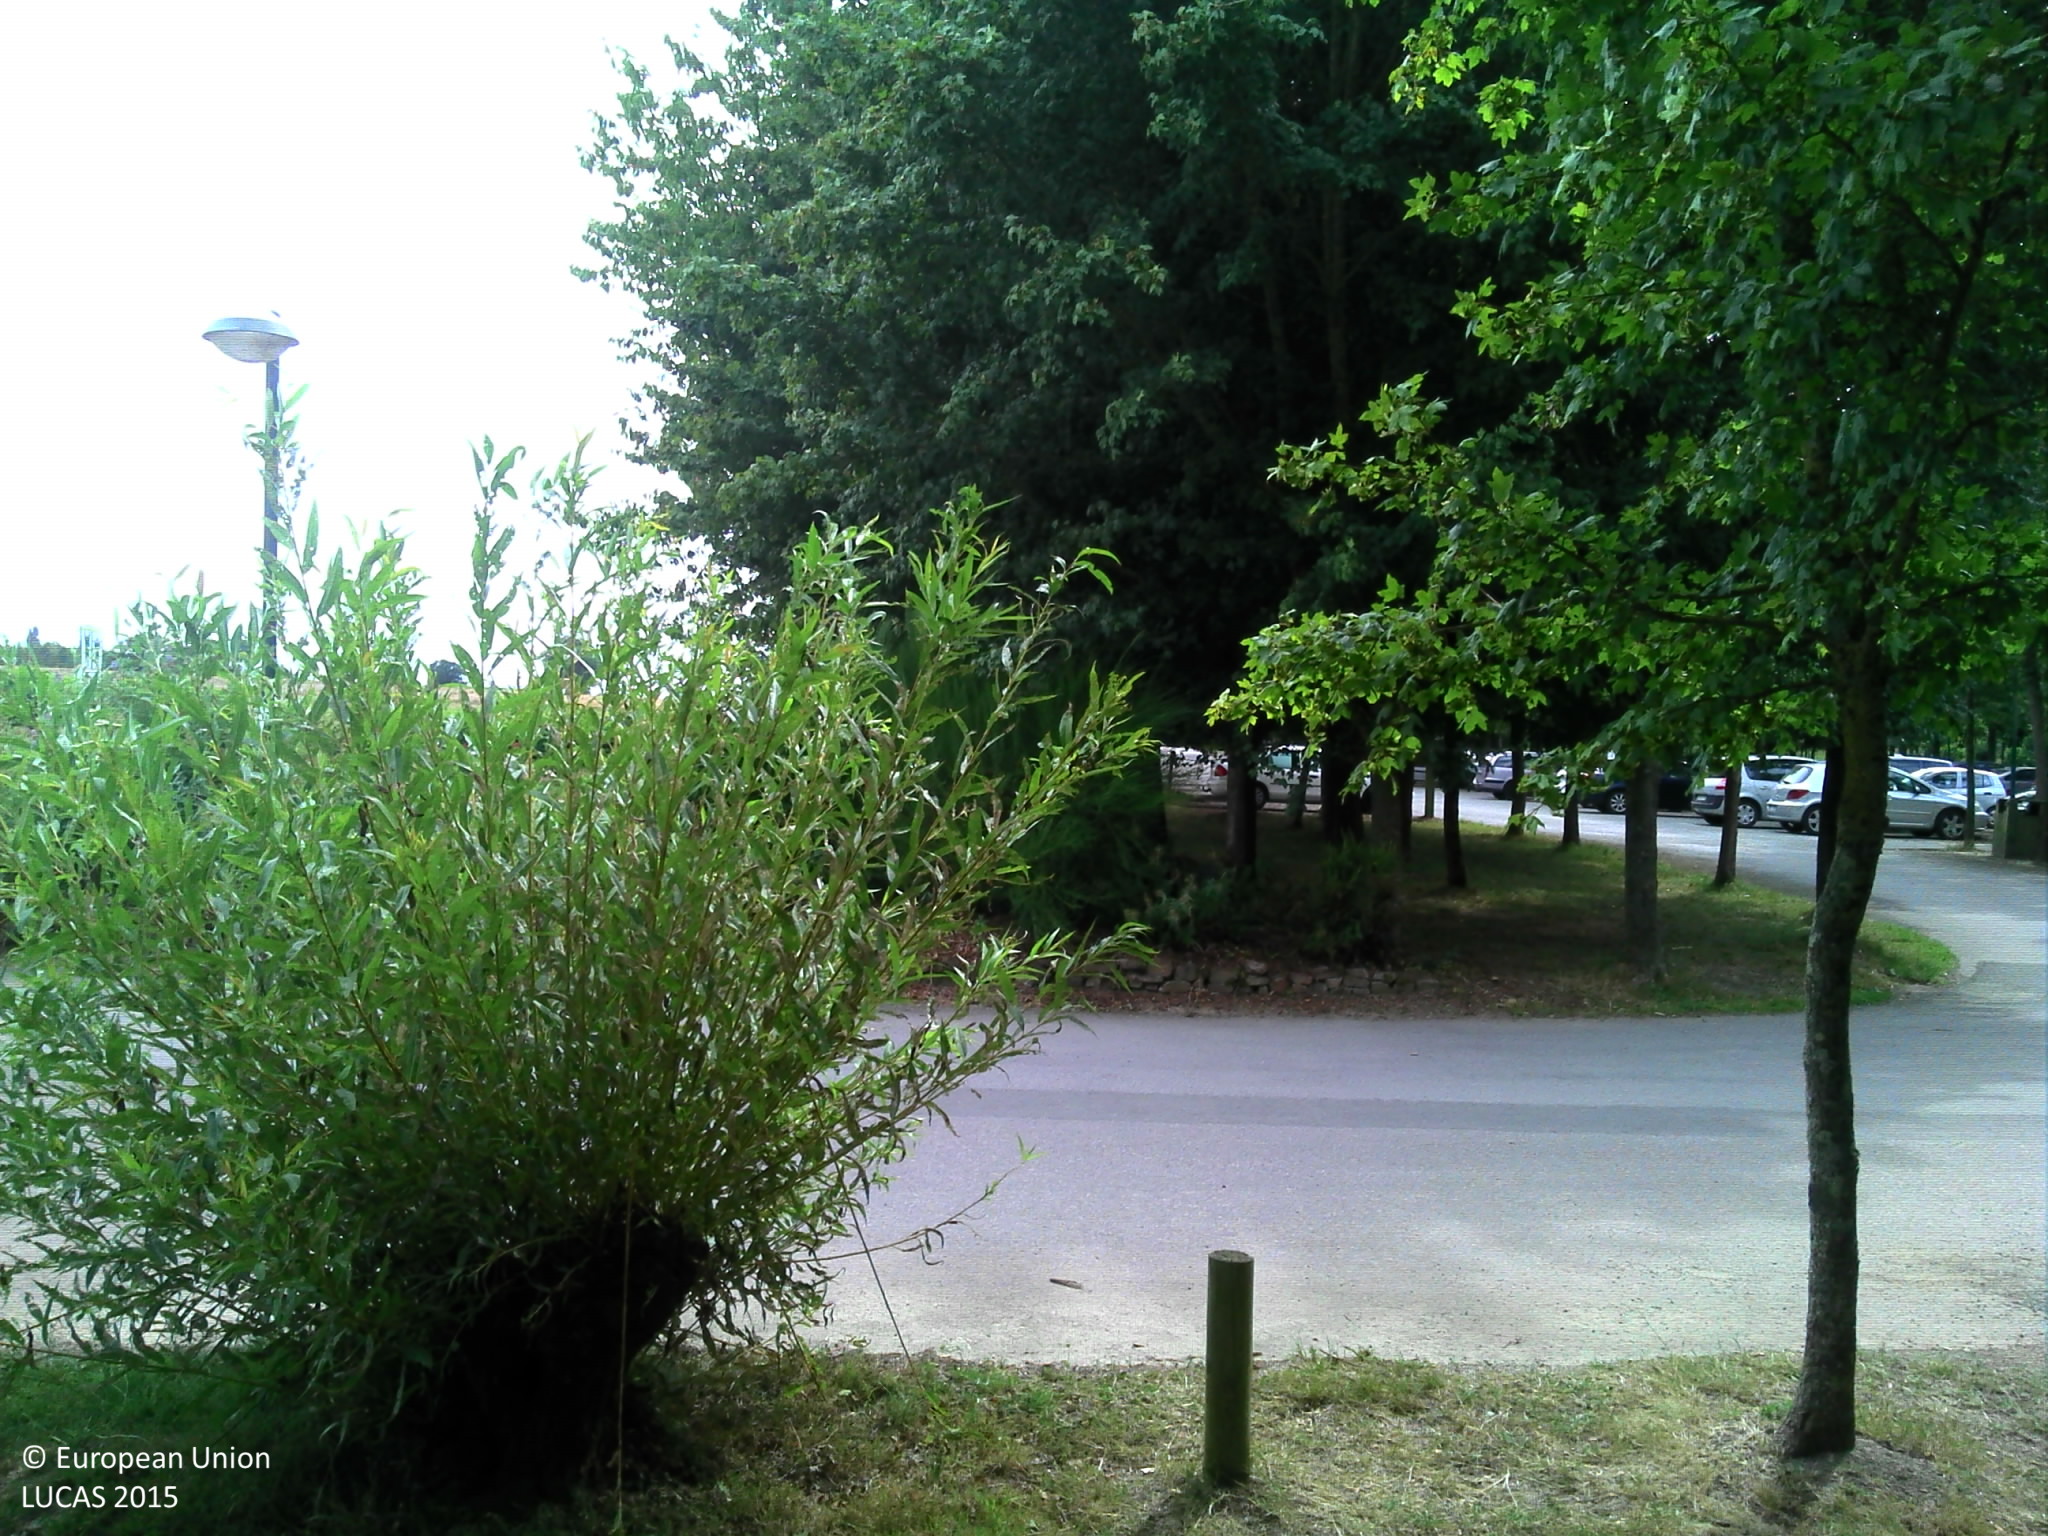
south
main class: Woodland
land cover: Broadleaved woodland
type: mesophytic deciduous forest
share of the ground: > 75 %
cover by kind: broadleaved forest trees 95 %, herbaceous plants 5 %
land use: Amenities, museums, leisure
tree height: > 5 m
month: July
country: FR
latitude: 47.8642
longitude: -1.0674
